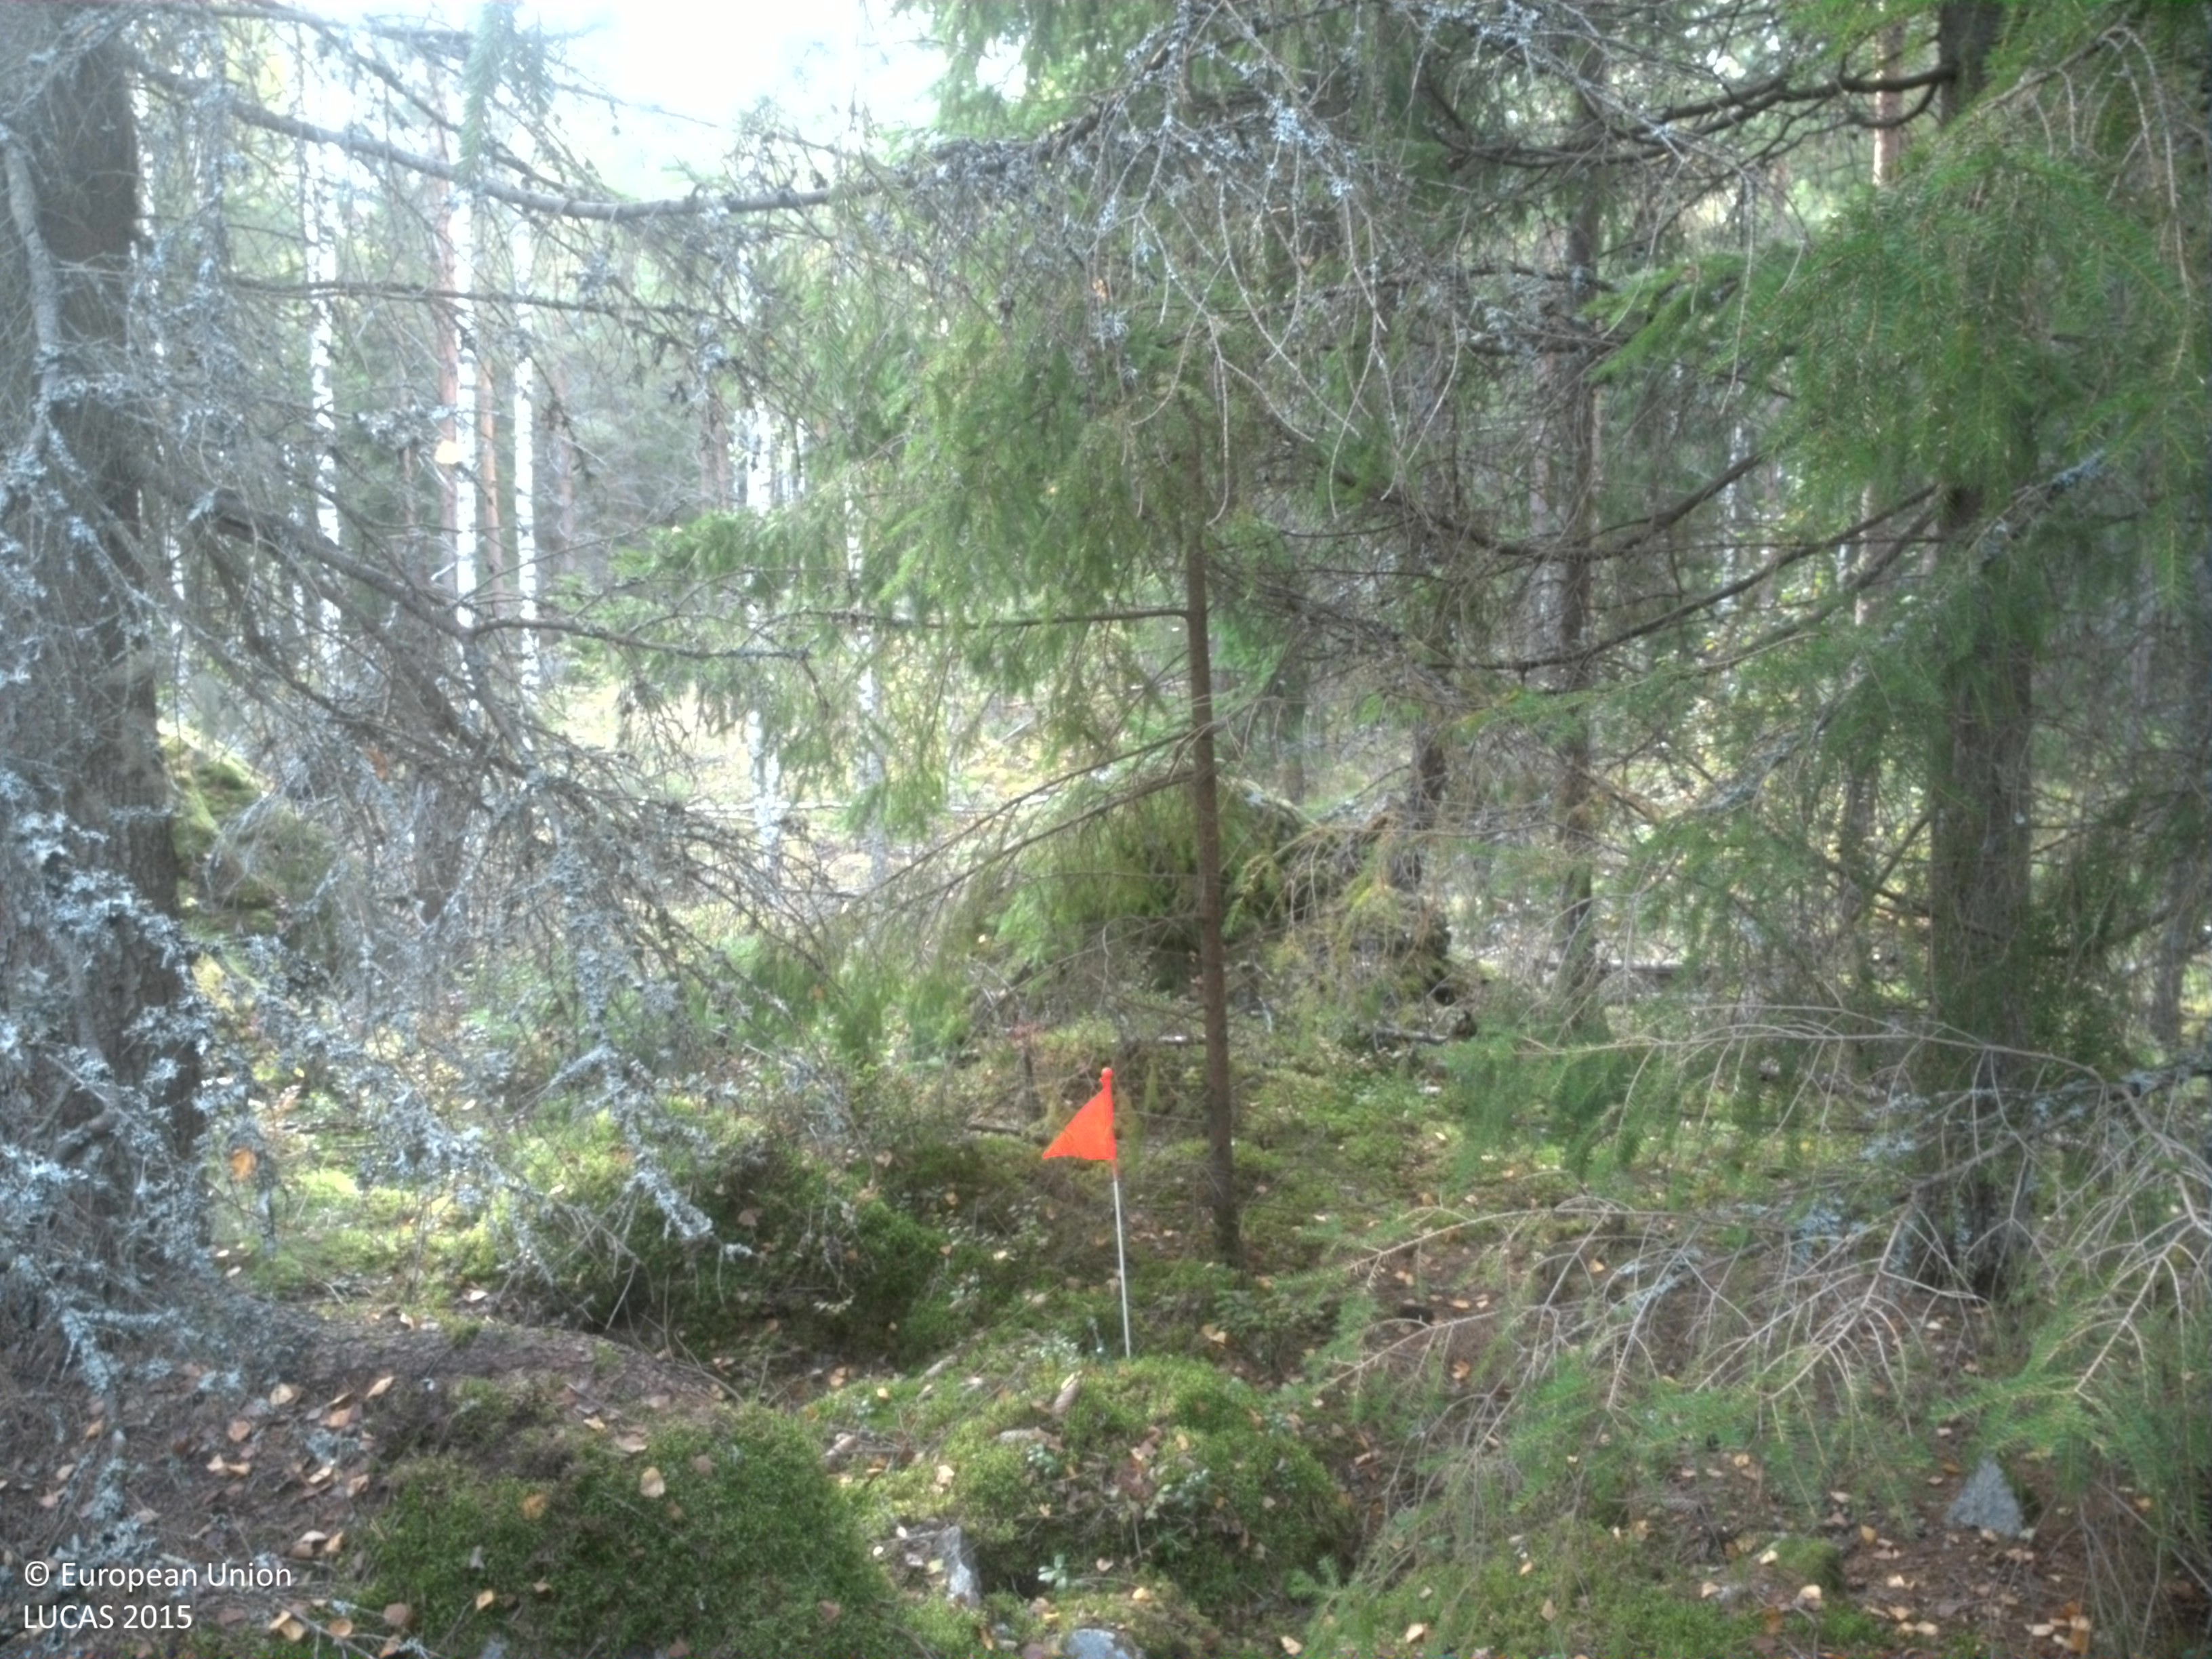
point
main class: Woodland
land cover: Spruce dominated mixed woodland
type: boreal forest
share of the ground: 50 - 75 %
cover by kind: coniferous forest trees 40 %, broadleaved forest trees 25 %, shrubs 20 %, lichens and mosses 10 %, consolidated bare surface 5 %
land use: Forestry
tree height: > 5 m
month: September
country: SE
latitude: 59.5338
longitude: 15.4547
